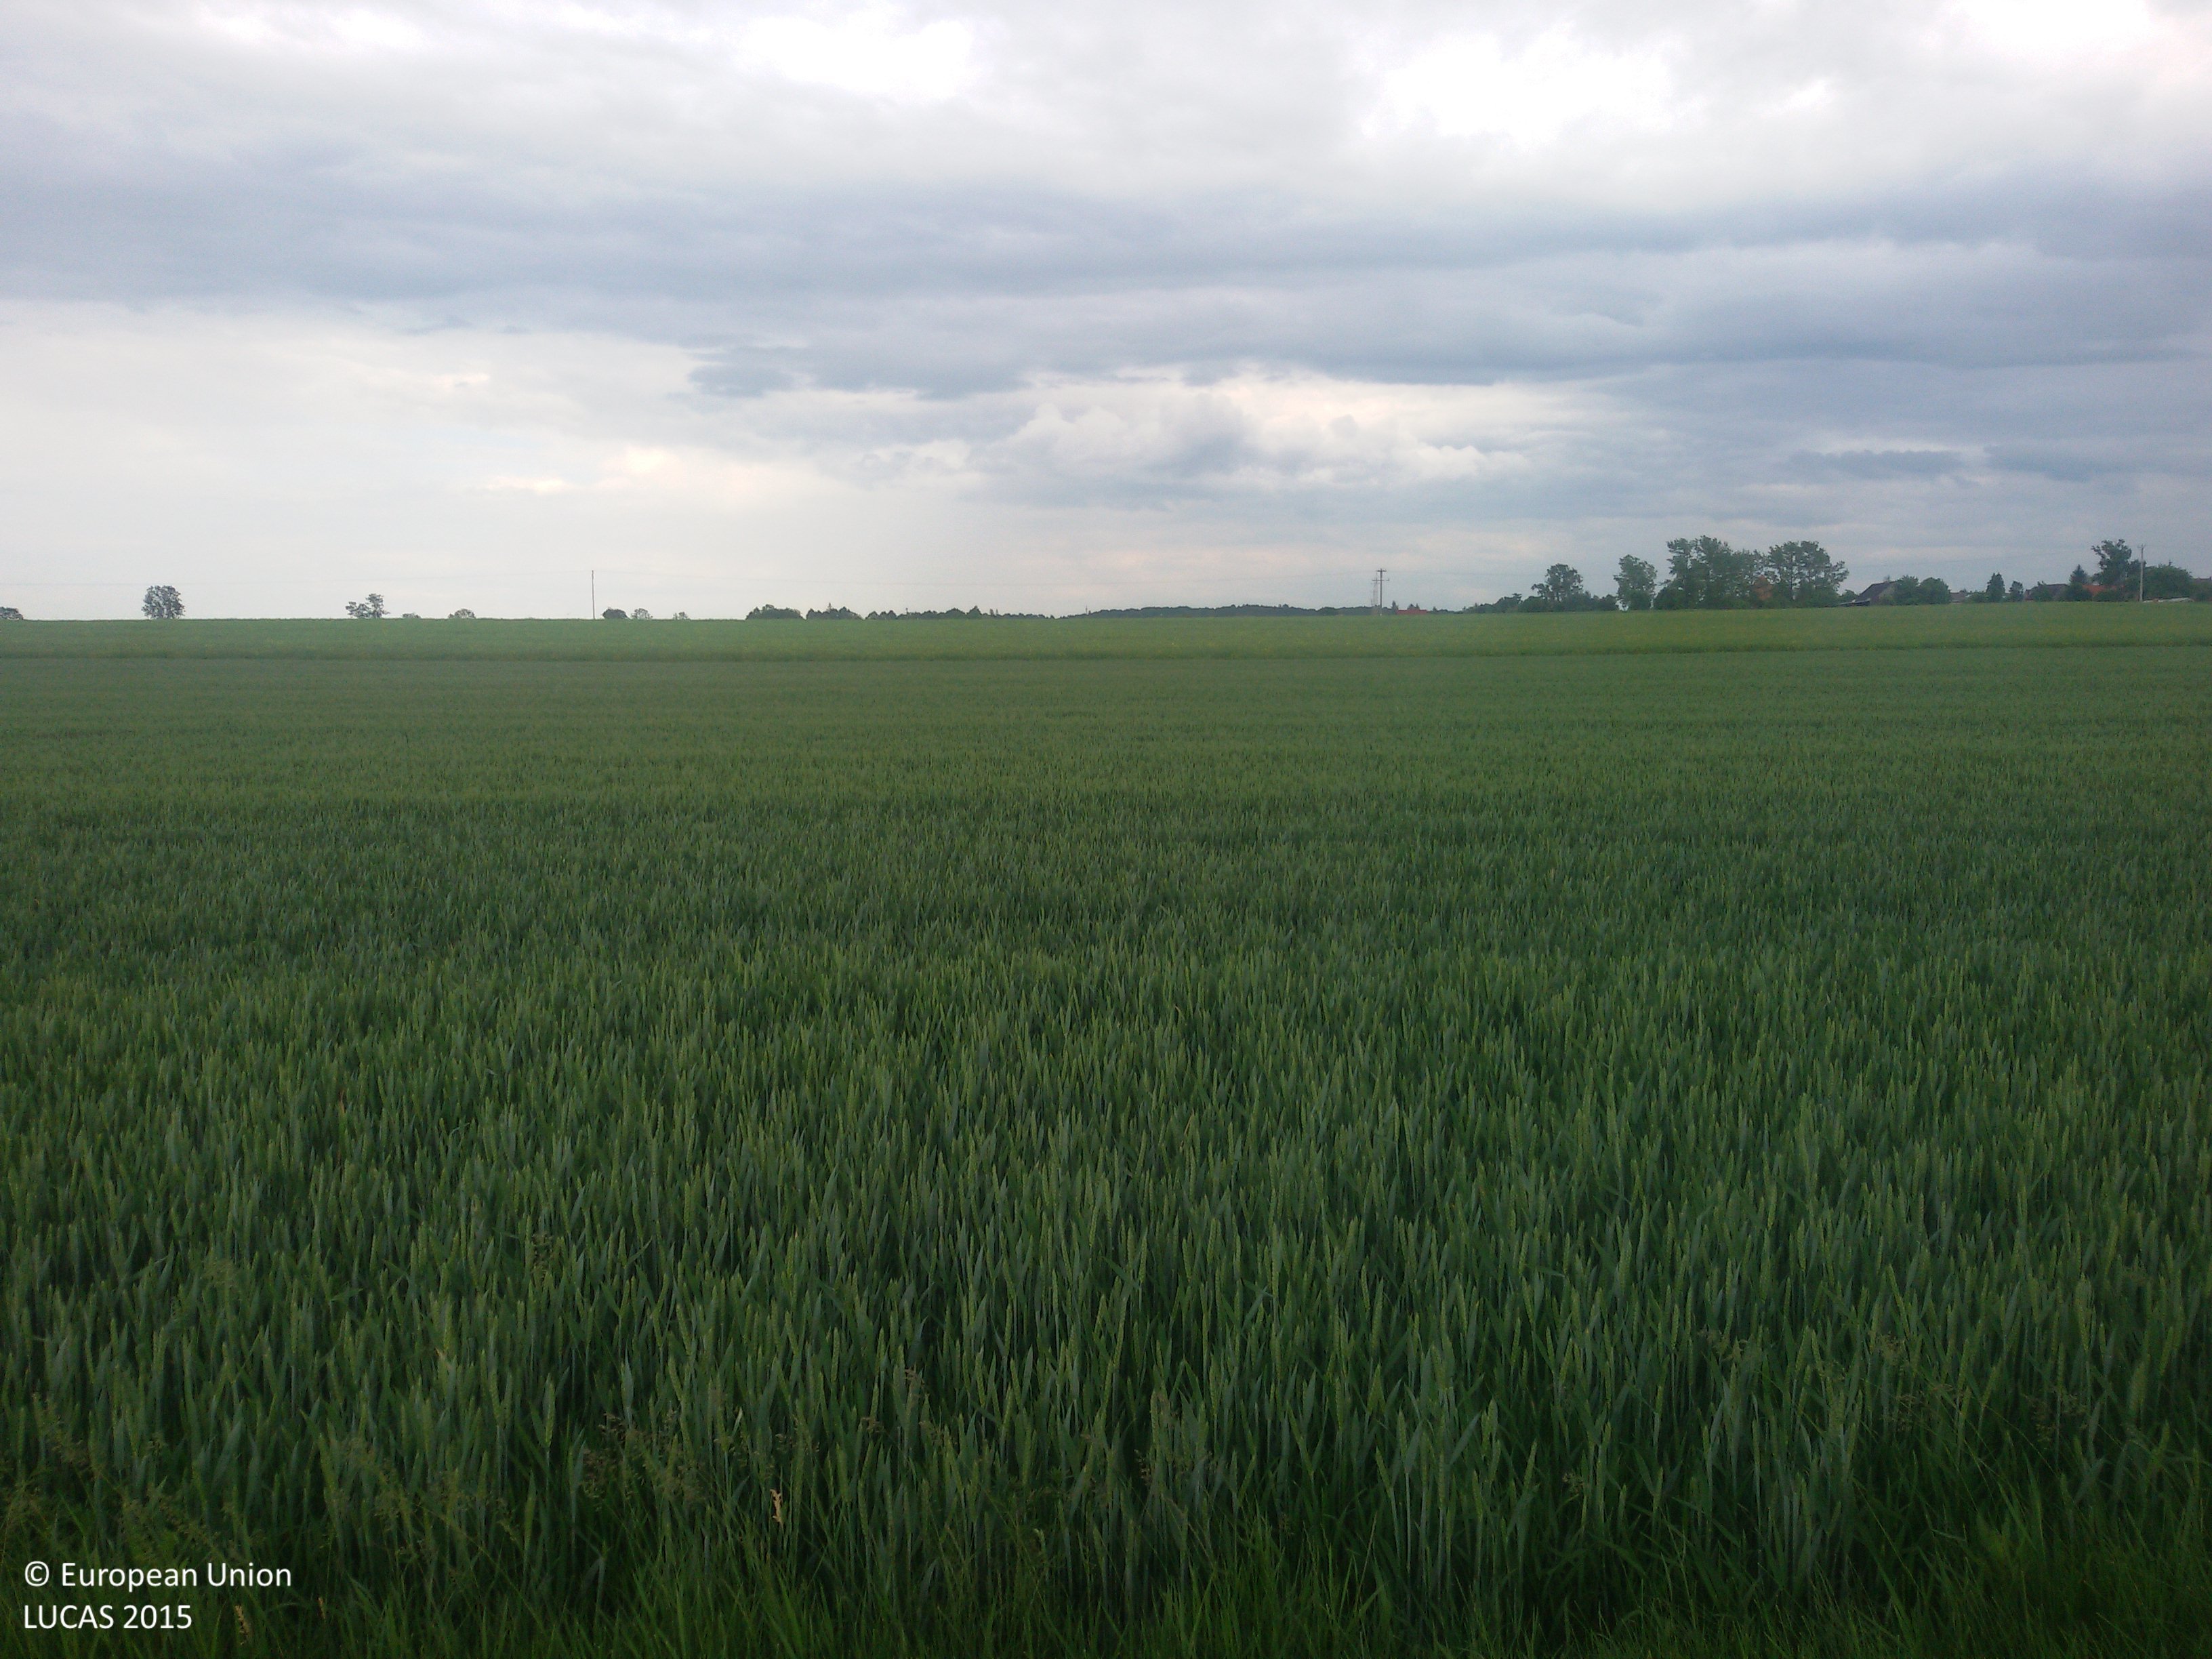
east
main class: Cropland
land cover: Common wheat
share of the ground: > 75 %
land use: Agriculture (excluding fallow land and kitchen gardens)
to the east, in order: Common wheat; Tracks; Common wheat; Rape and turnip rape
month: May
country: PL
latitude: 50.4095
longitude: 17.1732
